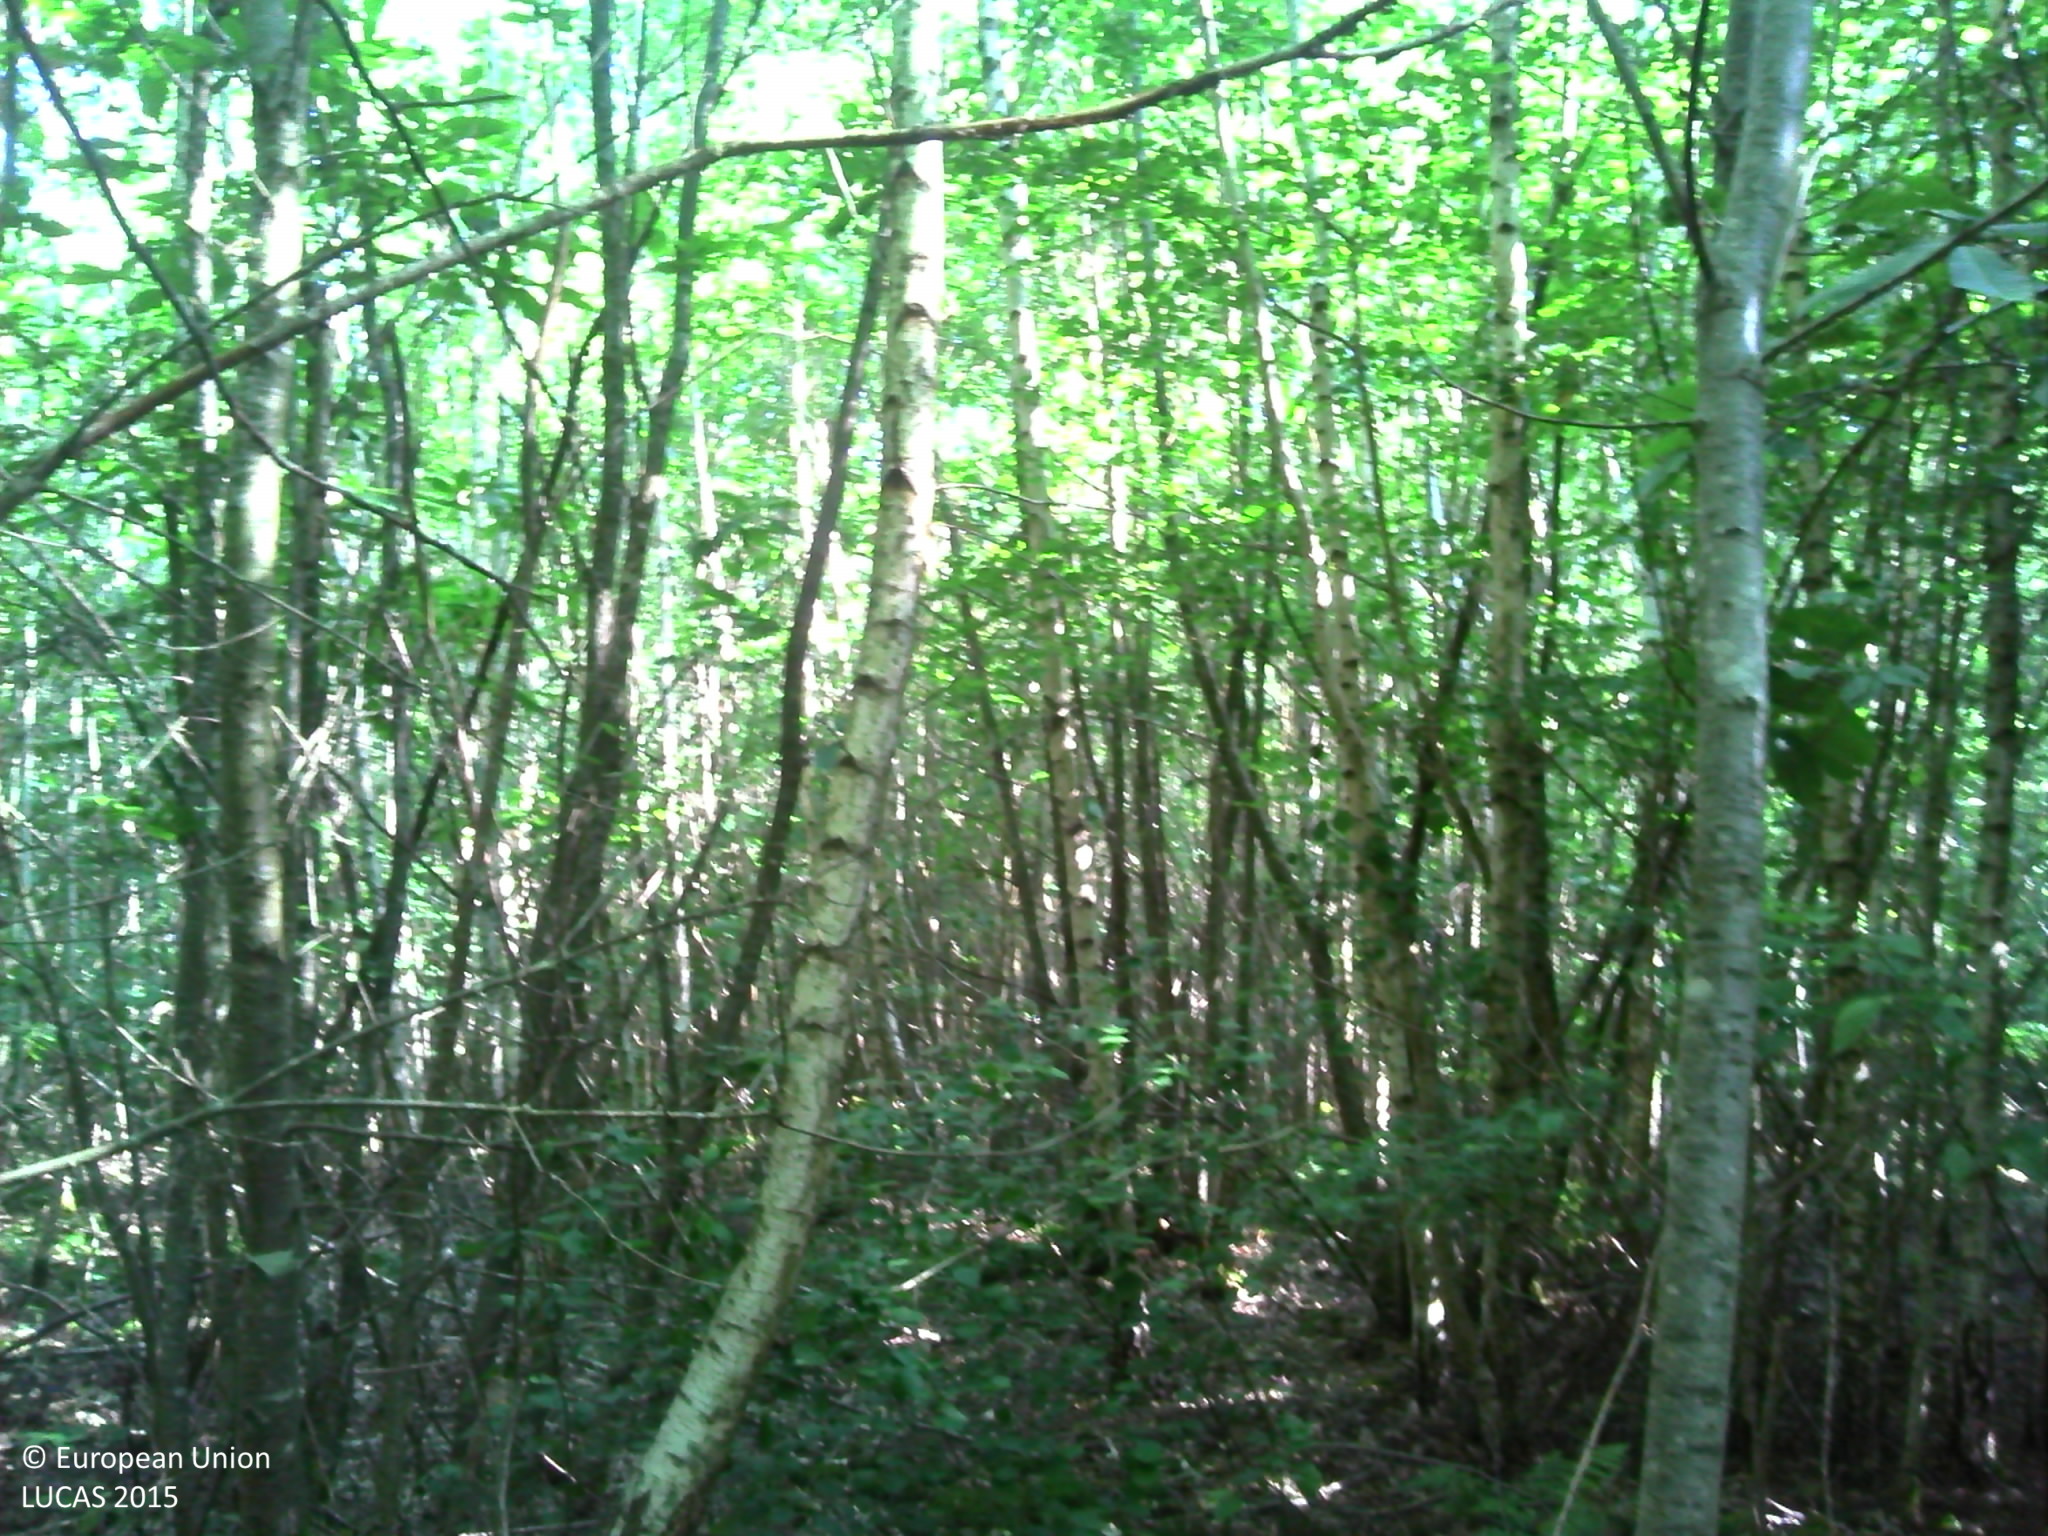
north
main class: Woodland
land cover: Broadleaved woodland
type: beech forest
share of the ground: > 75 %
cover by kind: broadleaved forest trees 70 %, herbaceous plants 20 %, lichens and mosses 10 %
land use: Forestry
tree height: > 5 m
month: June
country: FR
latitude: 47.7707
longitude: 0.0322
